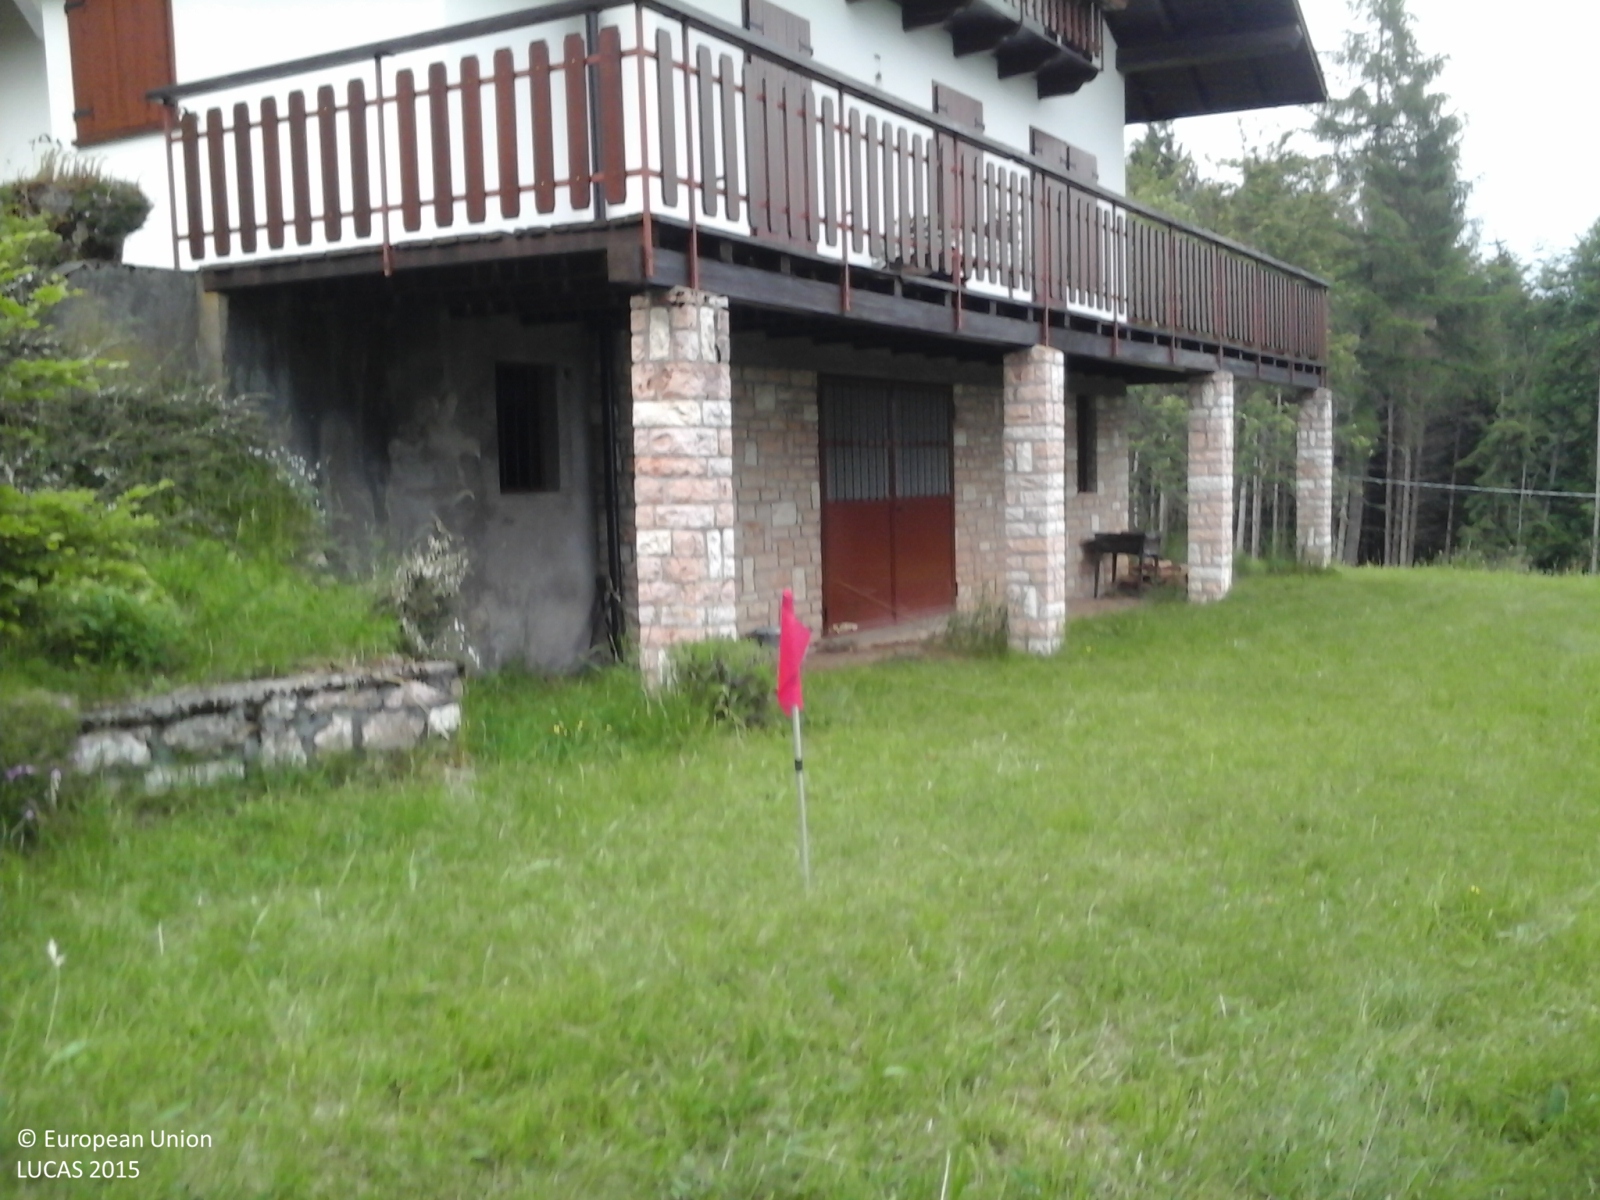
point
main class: Grassland
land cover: Grassland with sparse tree/shrub cover
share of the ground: > 75 %
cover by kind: herbaceous plants 80 %, broadleaved forest trees 5 %
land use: Residential
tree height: > 5 m
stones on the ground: < 10 %
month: May
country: IT
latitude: 46.0667
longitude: 11.7429
